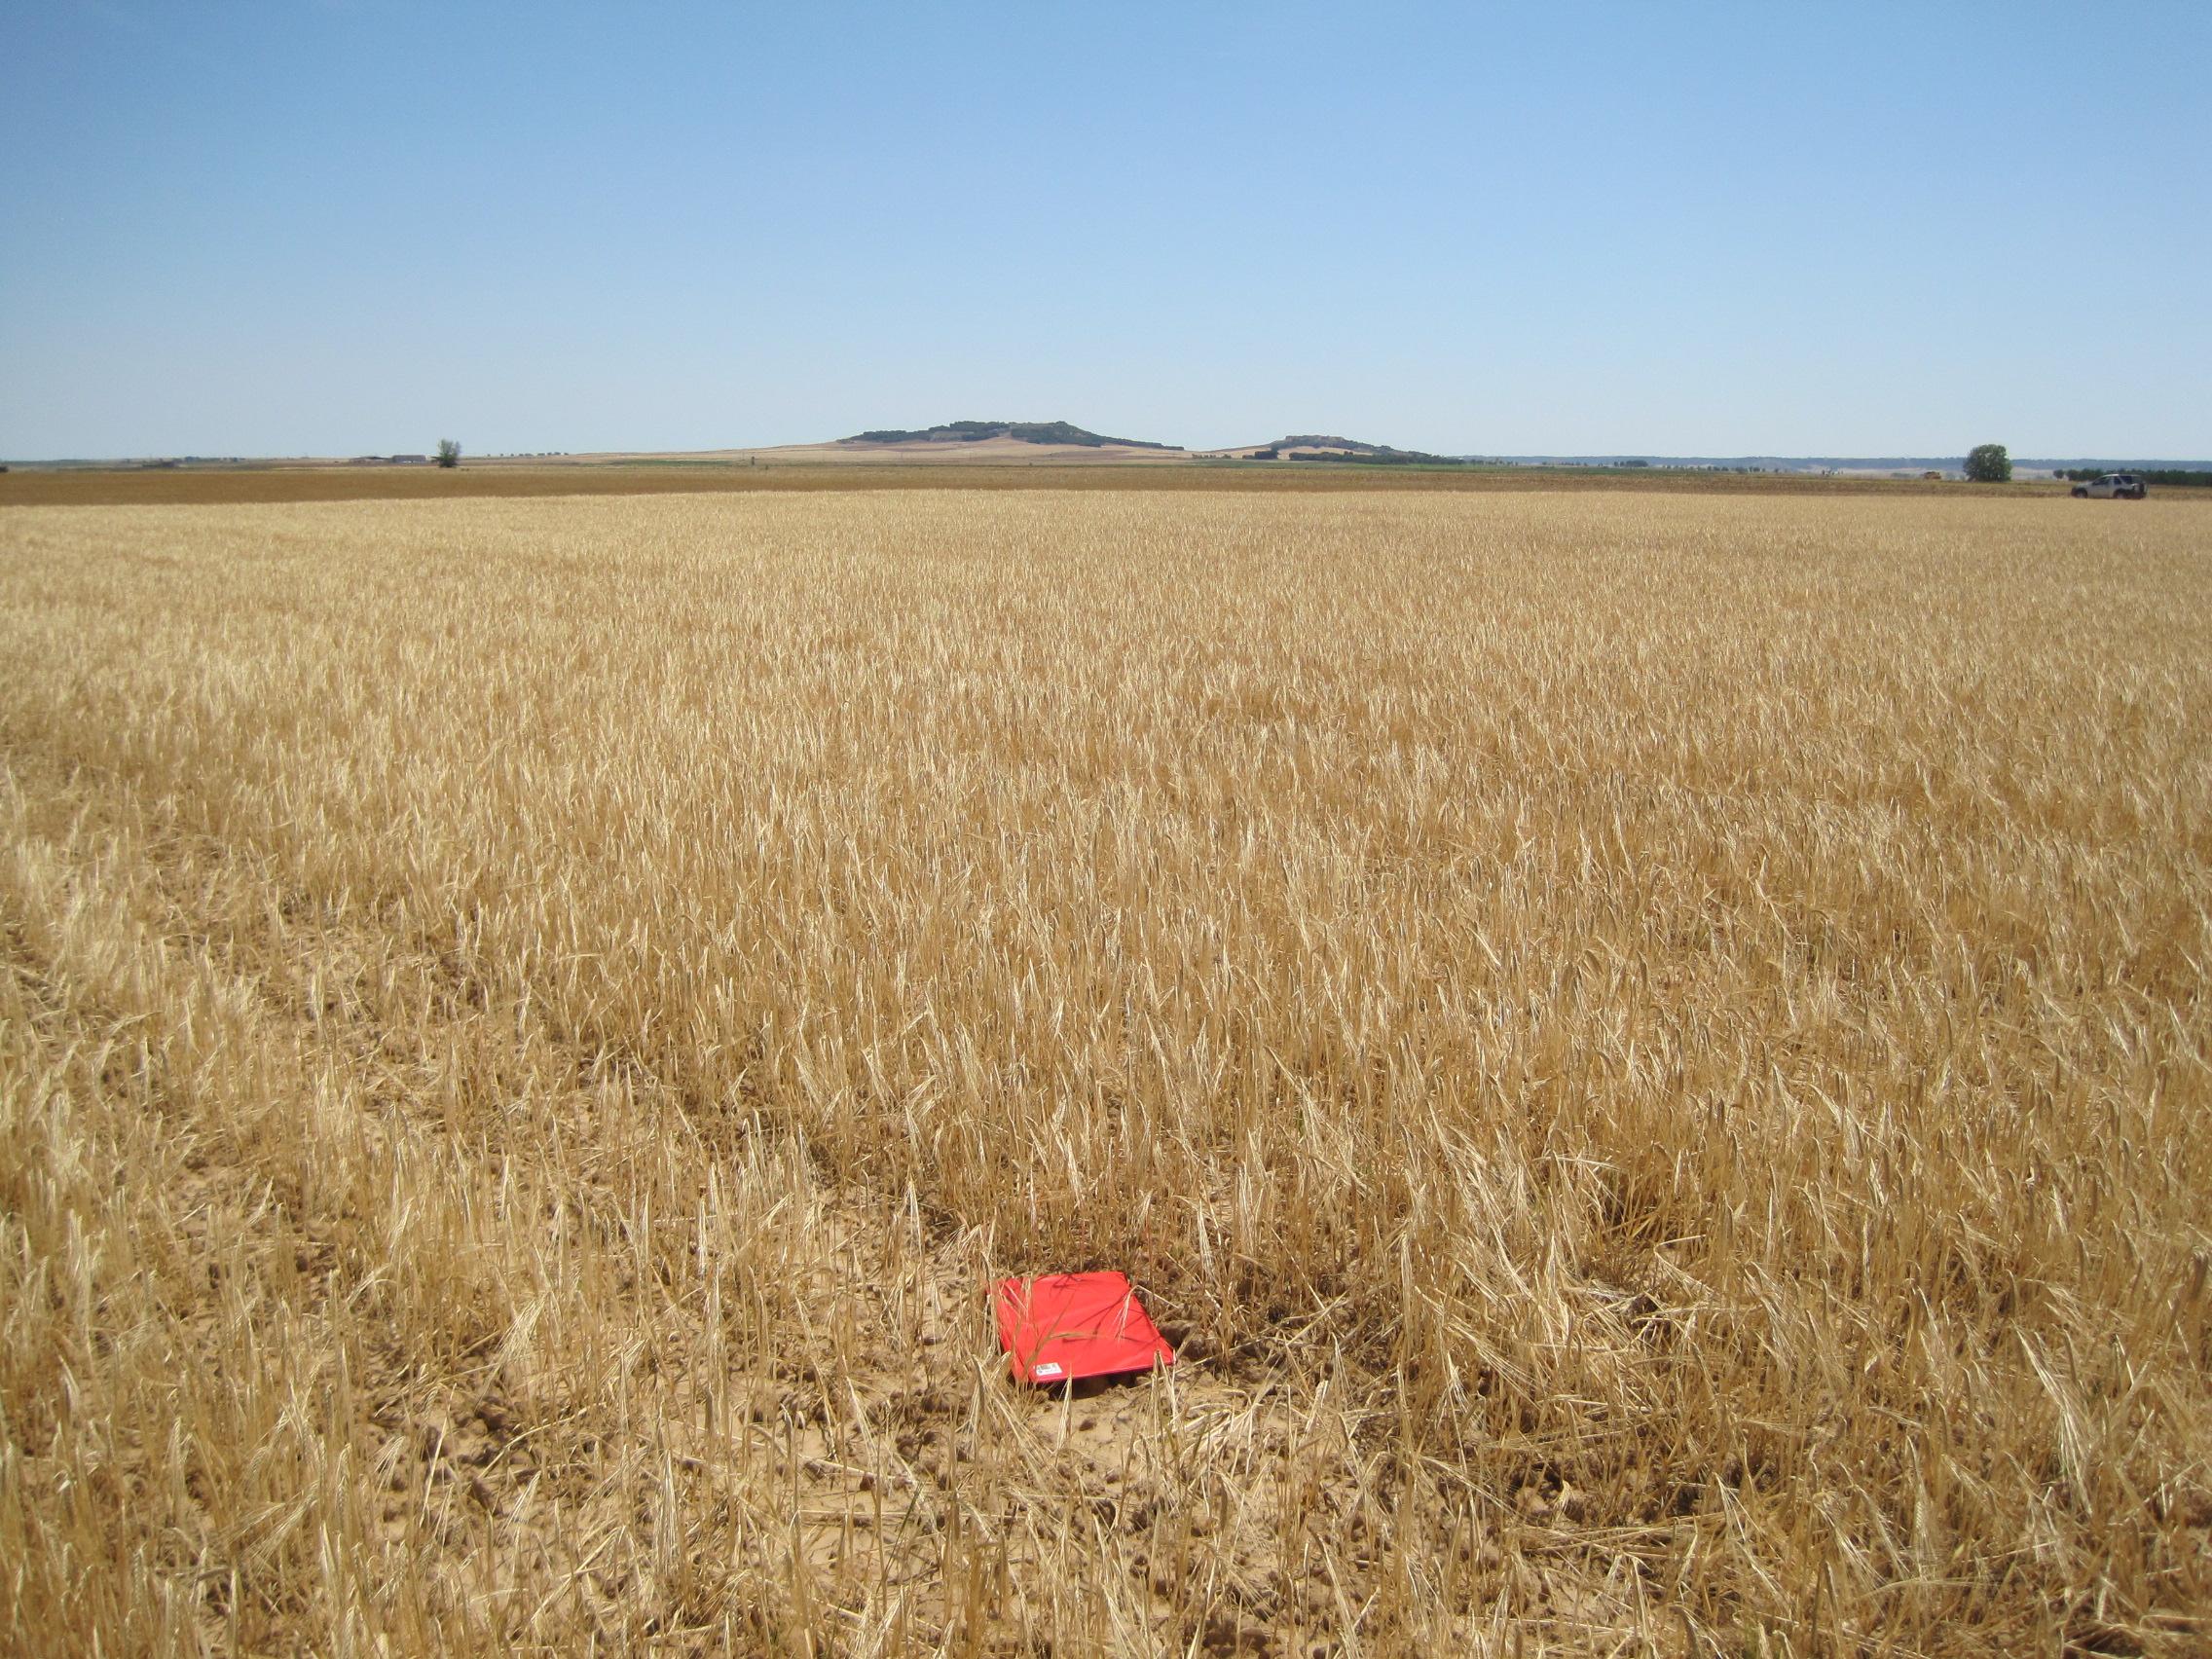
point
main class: Cropland
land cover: Barley
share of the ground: > 75 %
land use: Agriculture (excluding fallow land and kitchen gardens)
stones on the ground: < 10 %
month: June
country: ES
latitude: 41.8058
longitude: -5.2340
